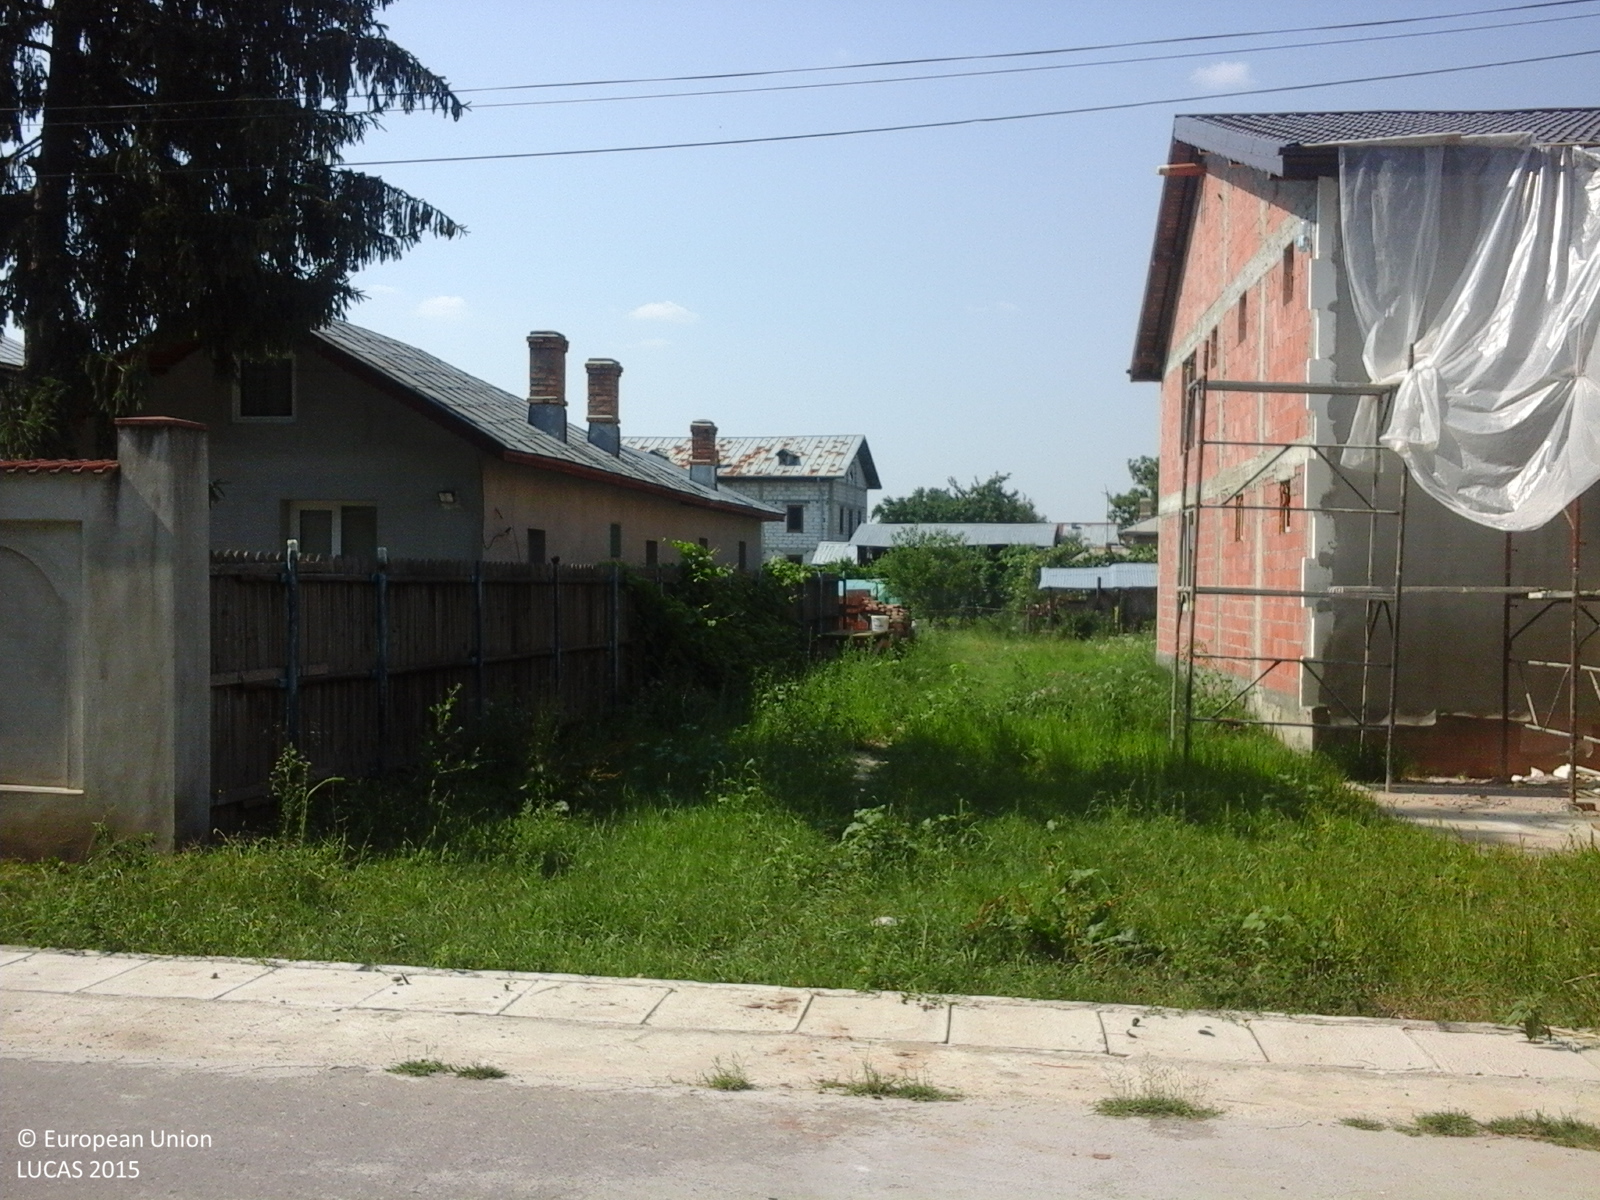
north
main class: Grassland
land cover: Spontaneously vegetated surfaces
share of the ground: > 75 %
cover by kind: herbaceous plants 100 %
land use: Fallow land
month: July
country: RO
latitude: 44.4970
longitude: 25.6264
